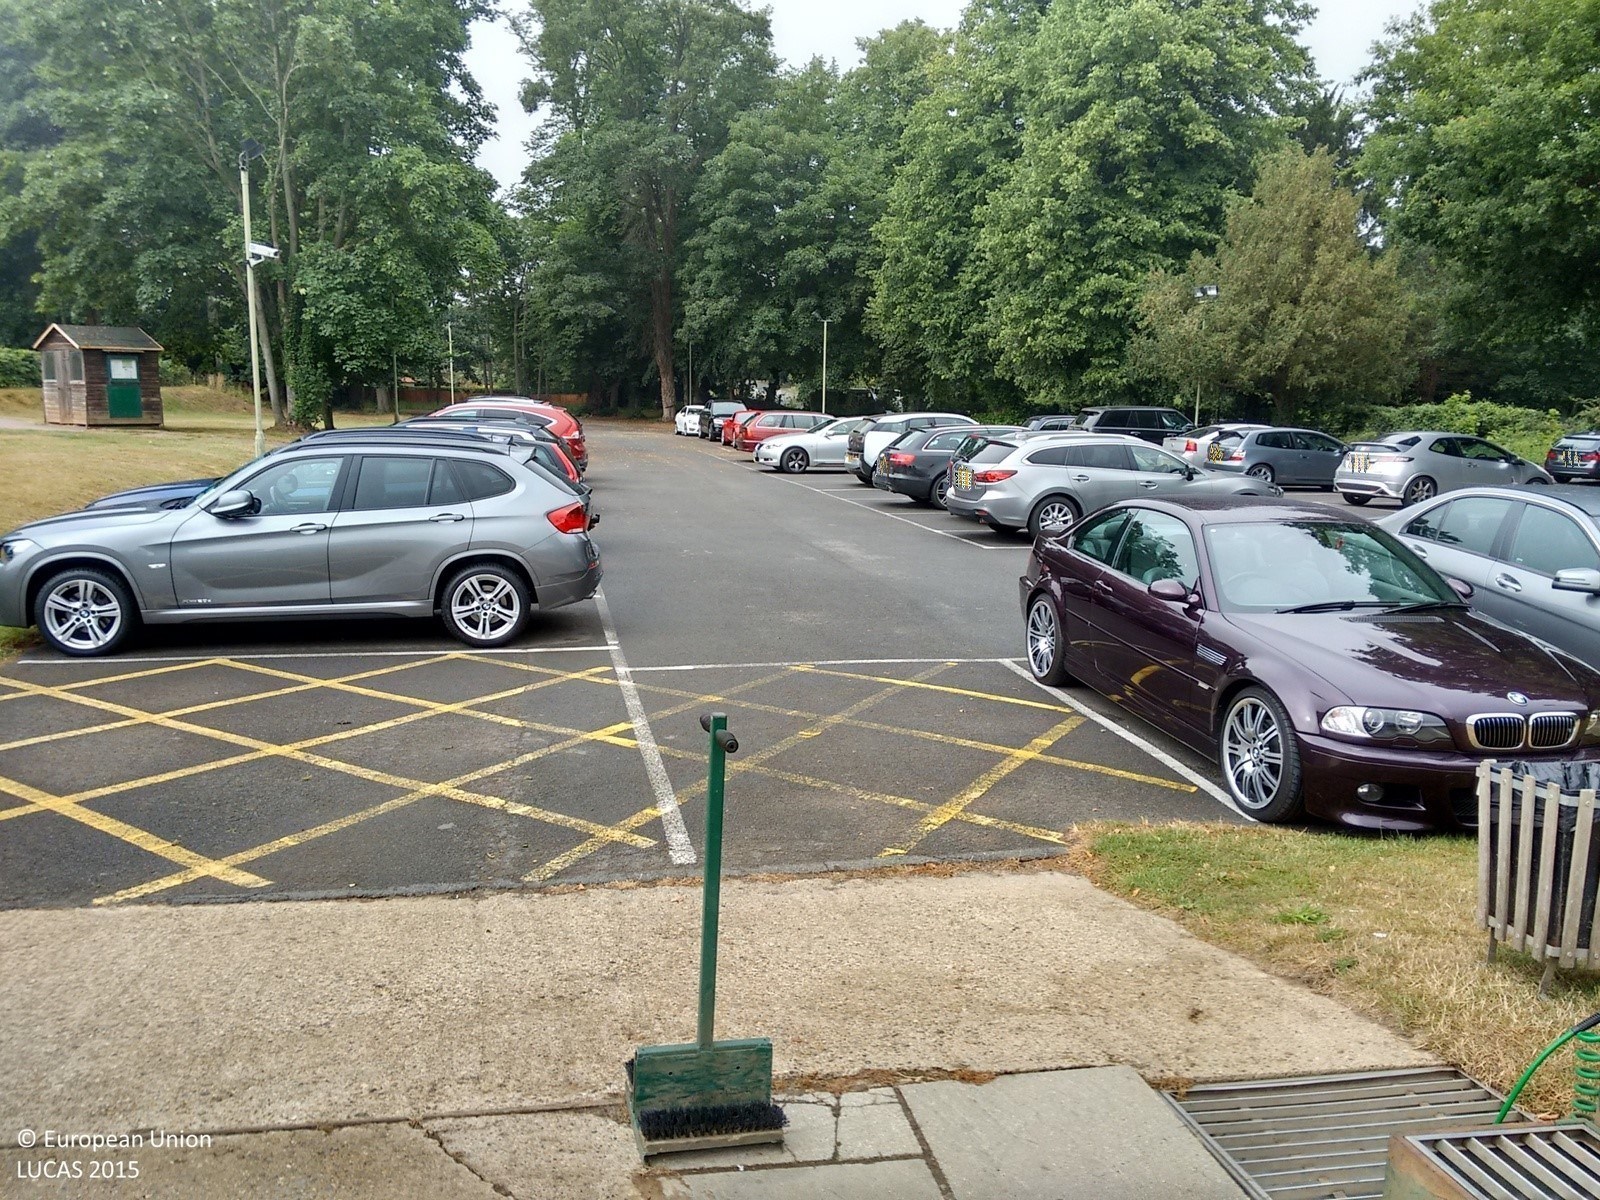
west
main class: Grassland
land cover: Grassland without tree/shrub cover
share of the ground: > 75 %
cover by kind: herbaceous plants 100 %
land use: Sport
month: July
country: GB
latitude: 51.2667
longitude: -0.3994
